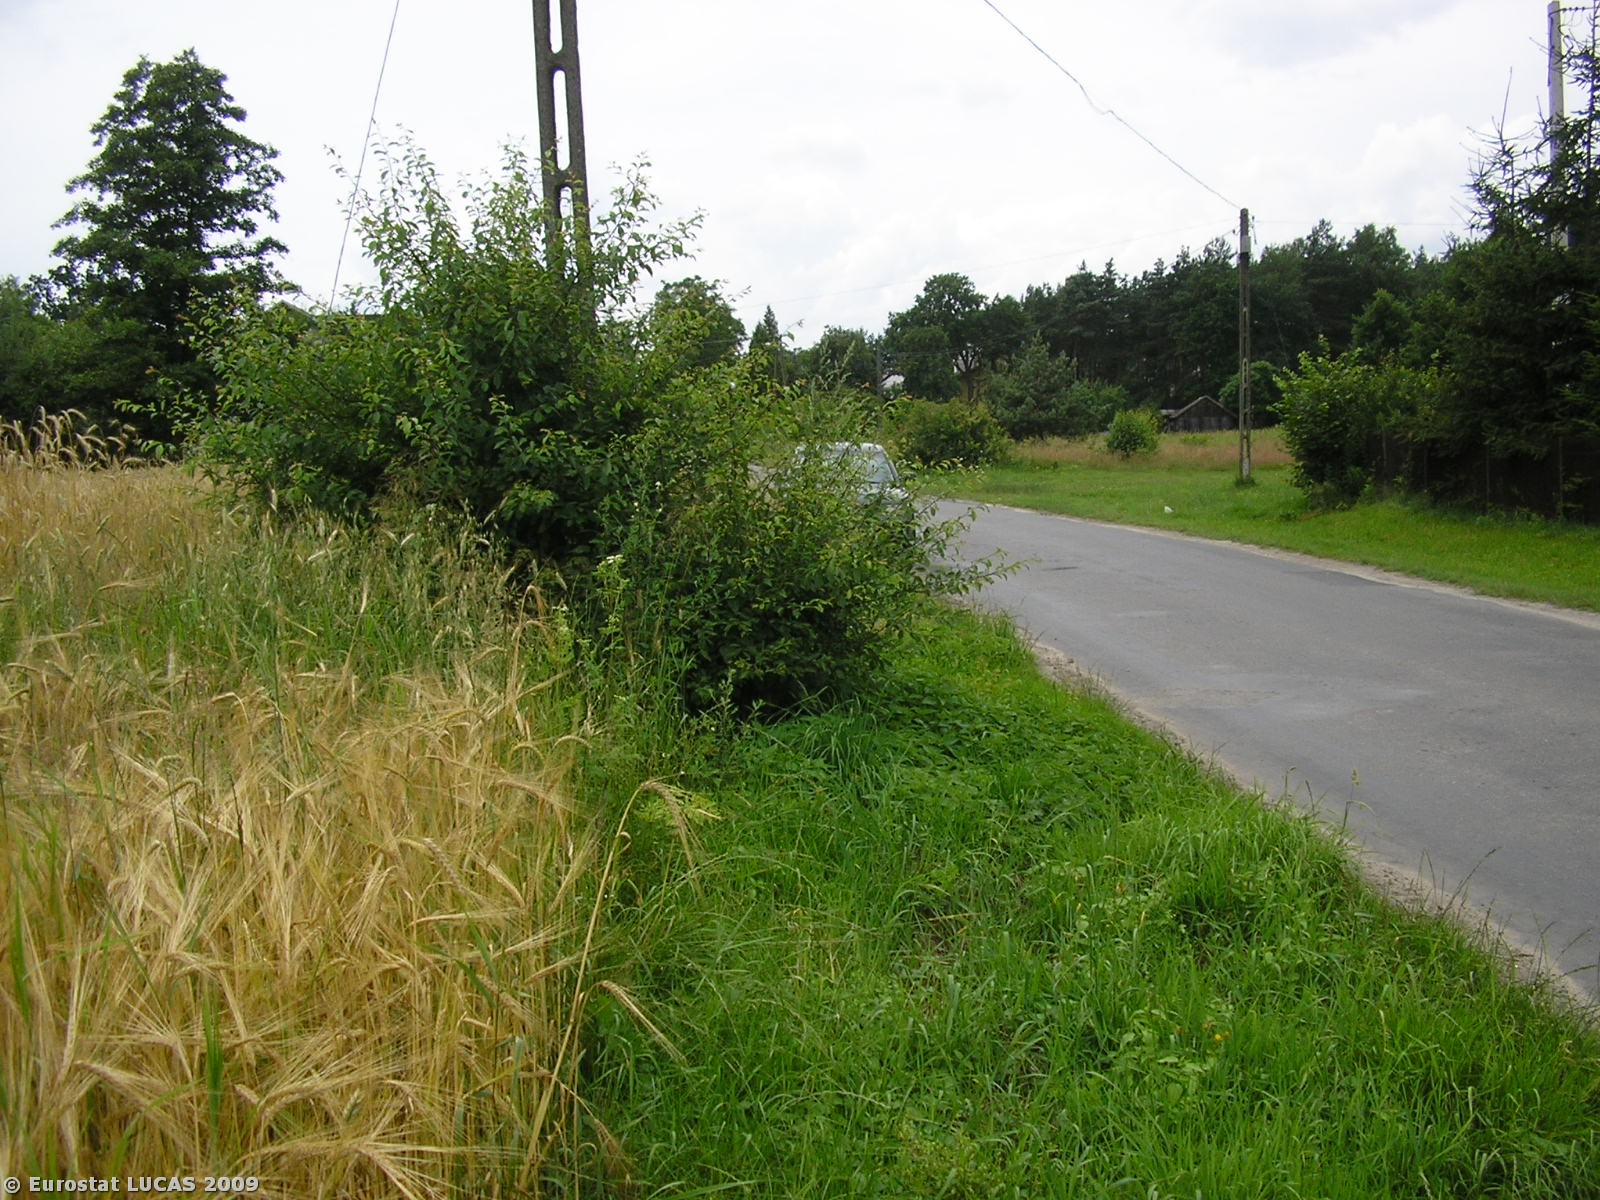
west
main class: Cropland
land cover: Barley
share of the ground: > 75 %
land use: Agriculture (excluding fallow land and kitchen gardens)
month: July
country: PL
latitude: 50.1491
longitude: 20.7182
